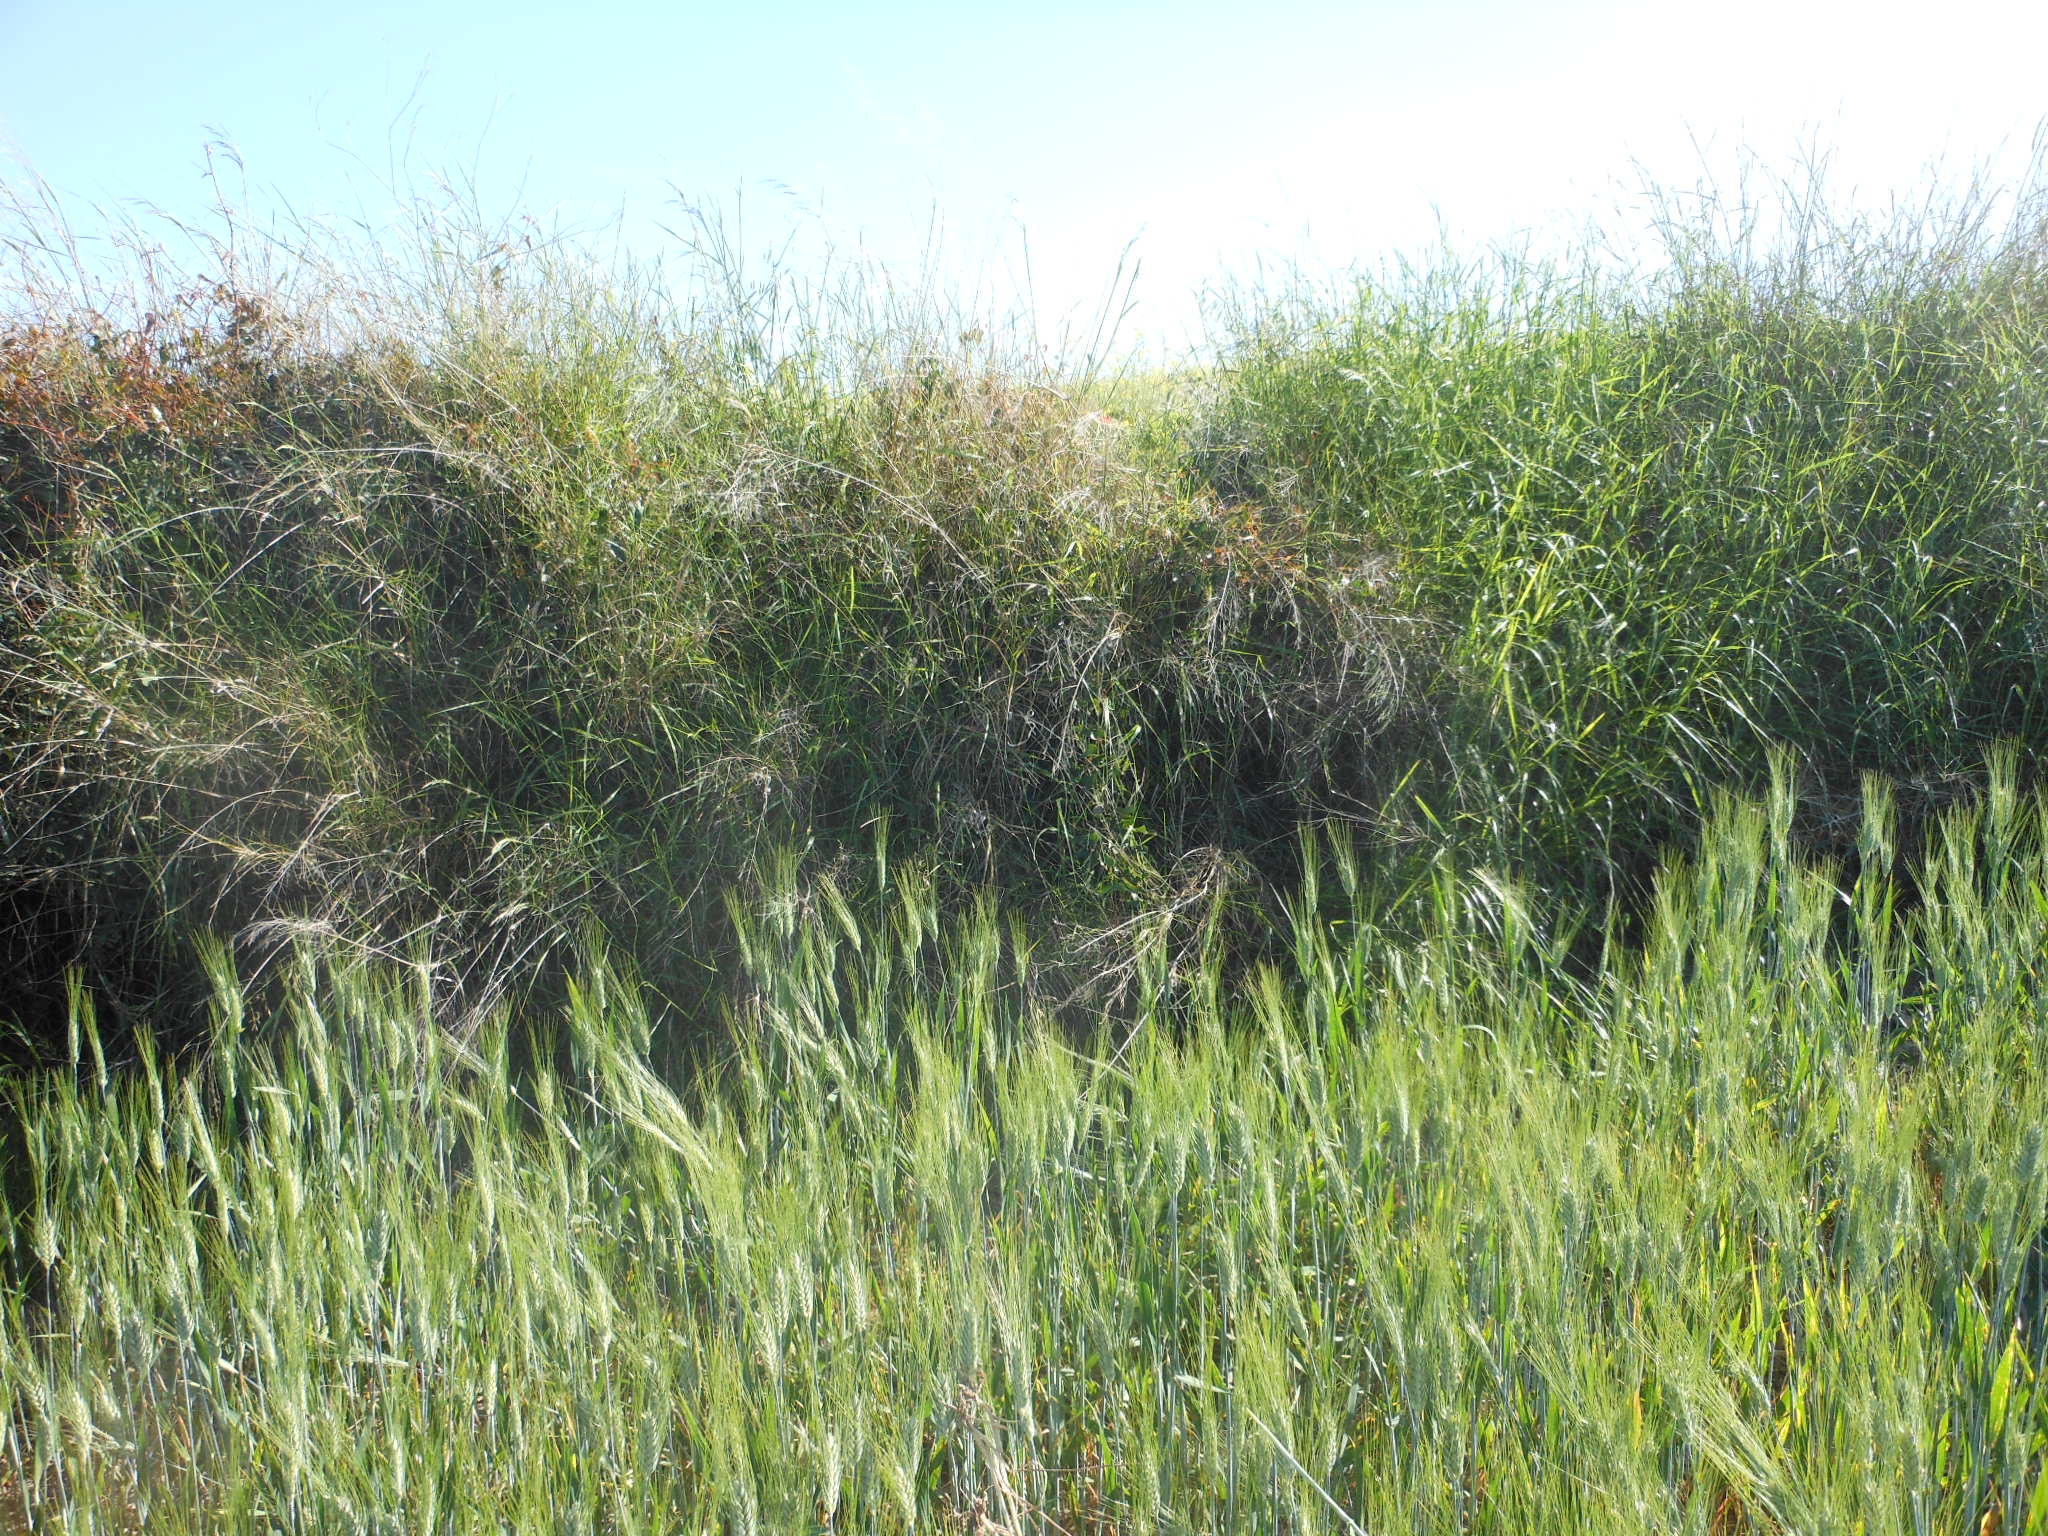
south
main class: Cropland
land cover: Durum wheat
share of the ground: > 75 %
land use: Agriculture (excluding fallow land and kitchen gardens)
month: April
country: ES
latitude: 37.1083
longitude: -5.5290
